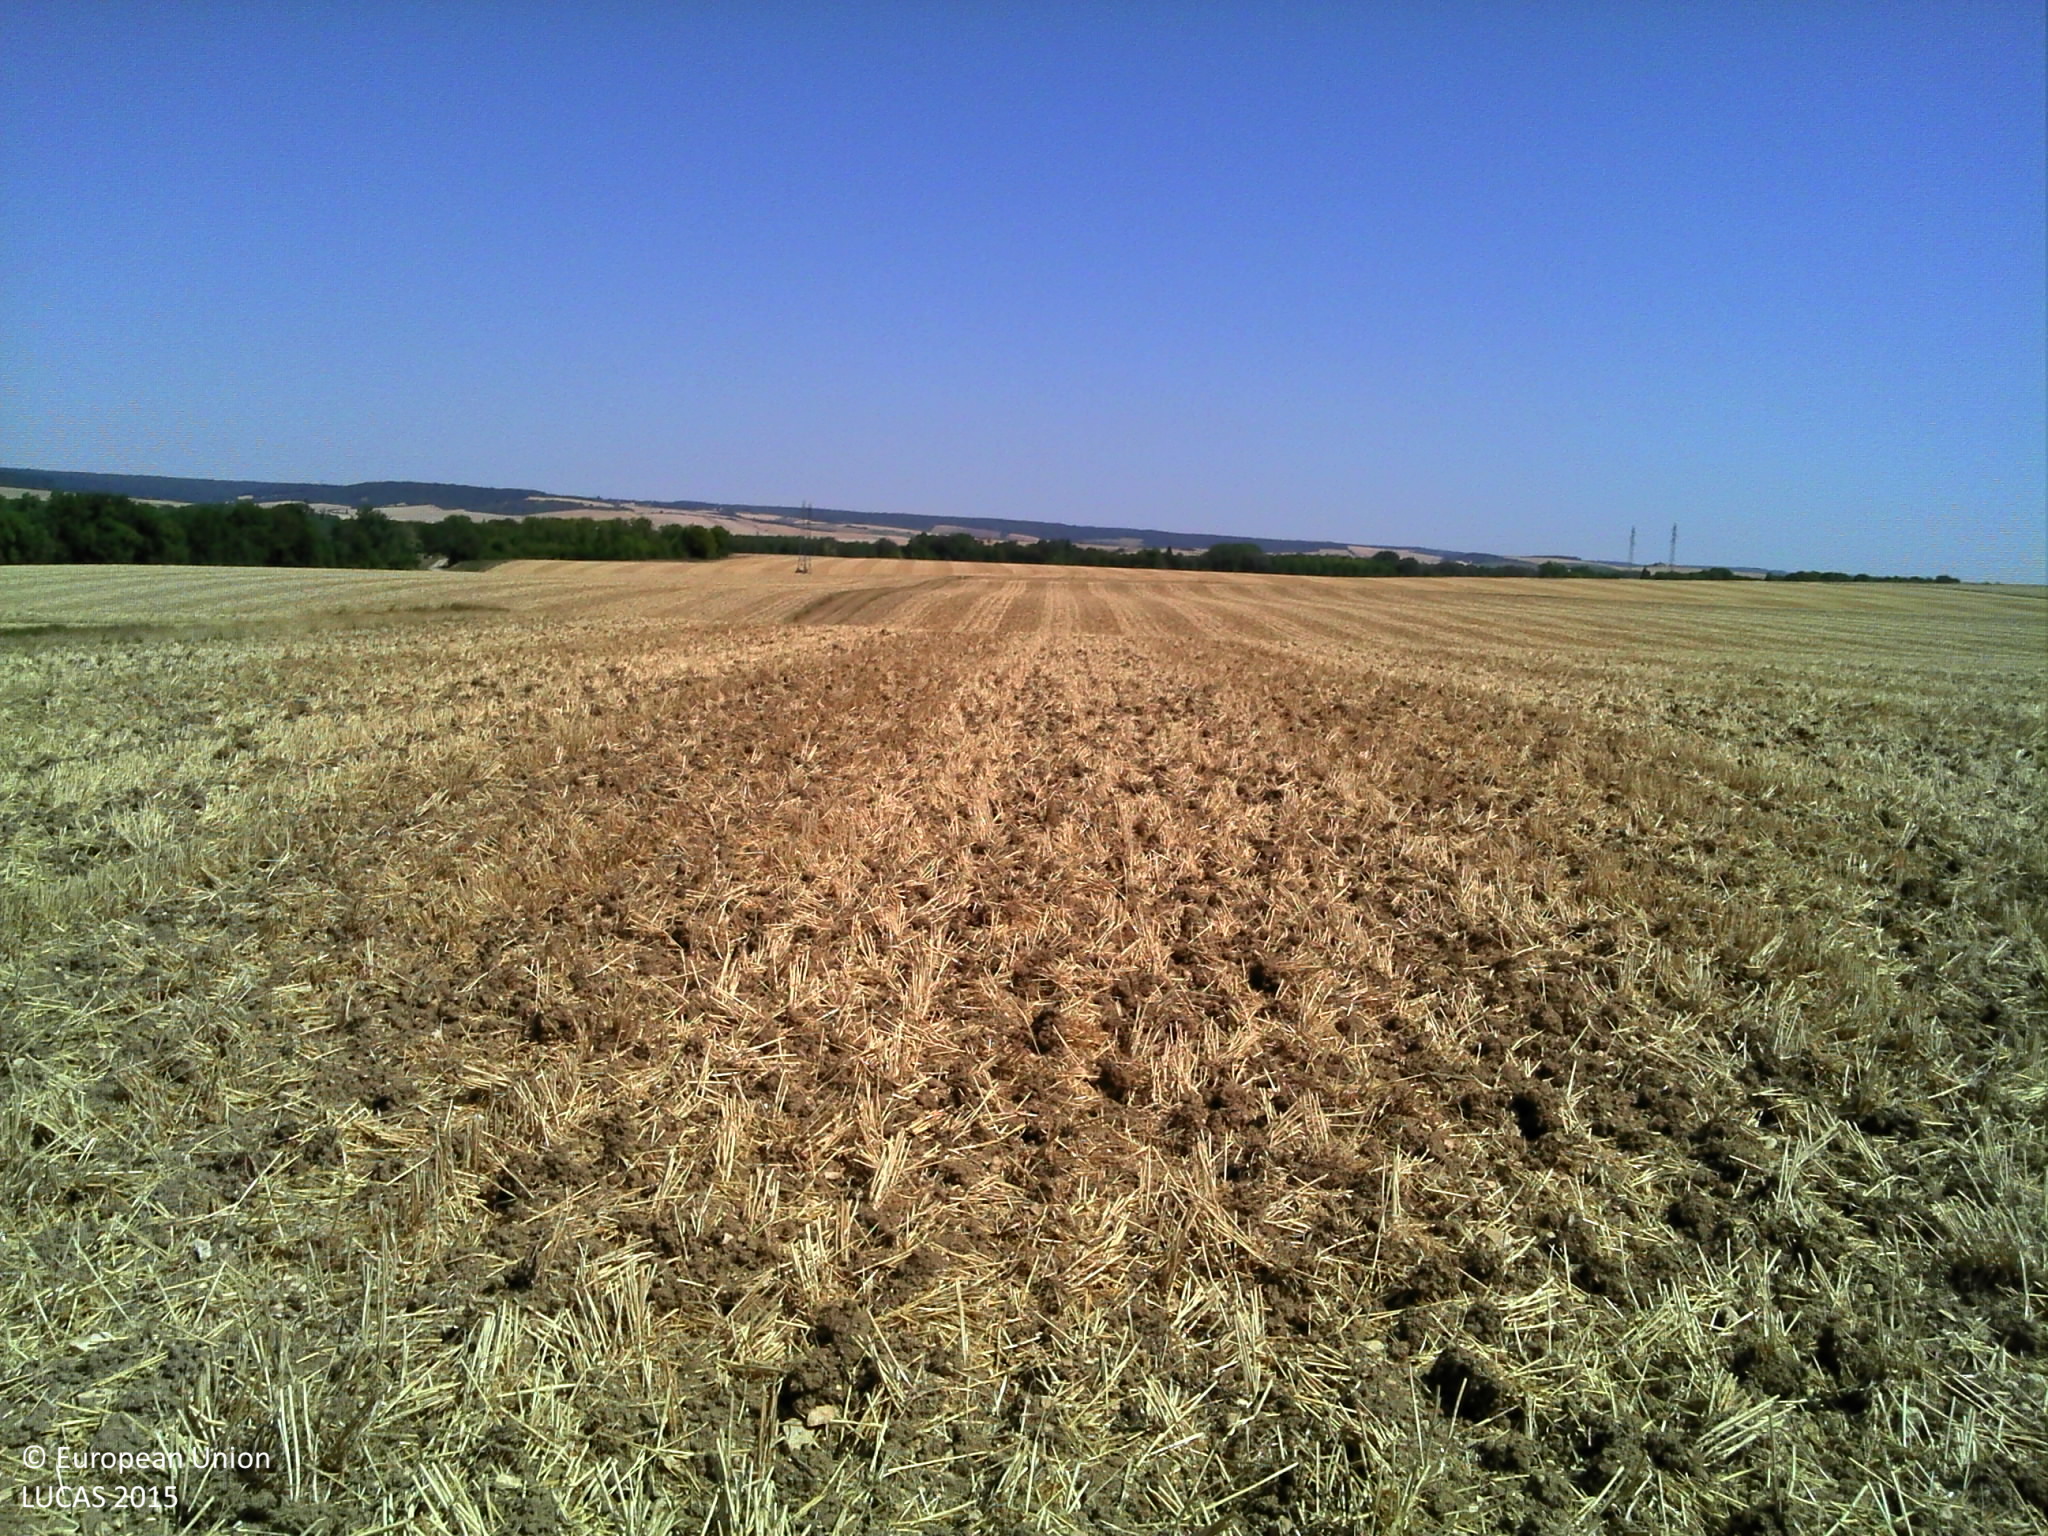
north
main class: Cropland
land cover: Common wheat
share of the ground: > 75 %
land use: Agriculture (excluding fallow land and kitchen gardens)
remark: Tilled/Sowed
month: August
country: FR
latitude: 47.9384
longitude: 3.4488
